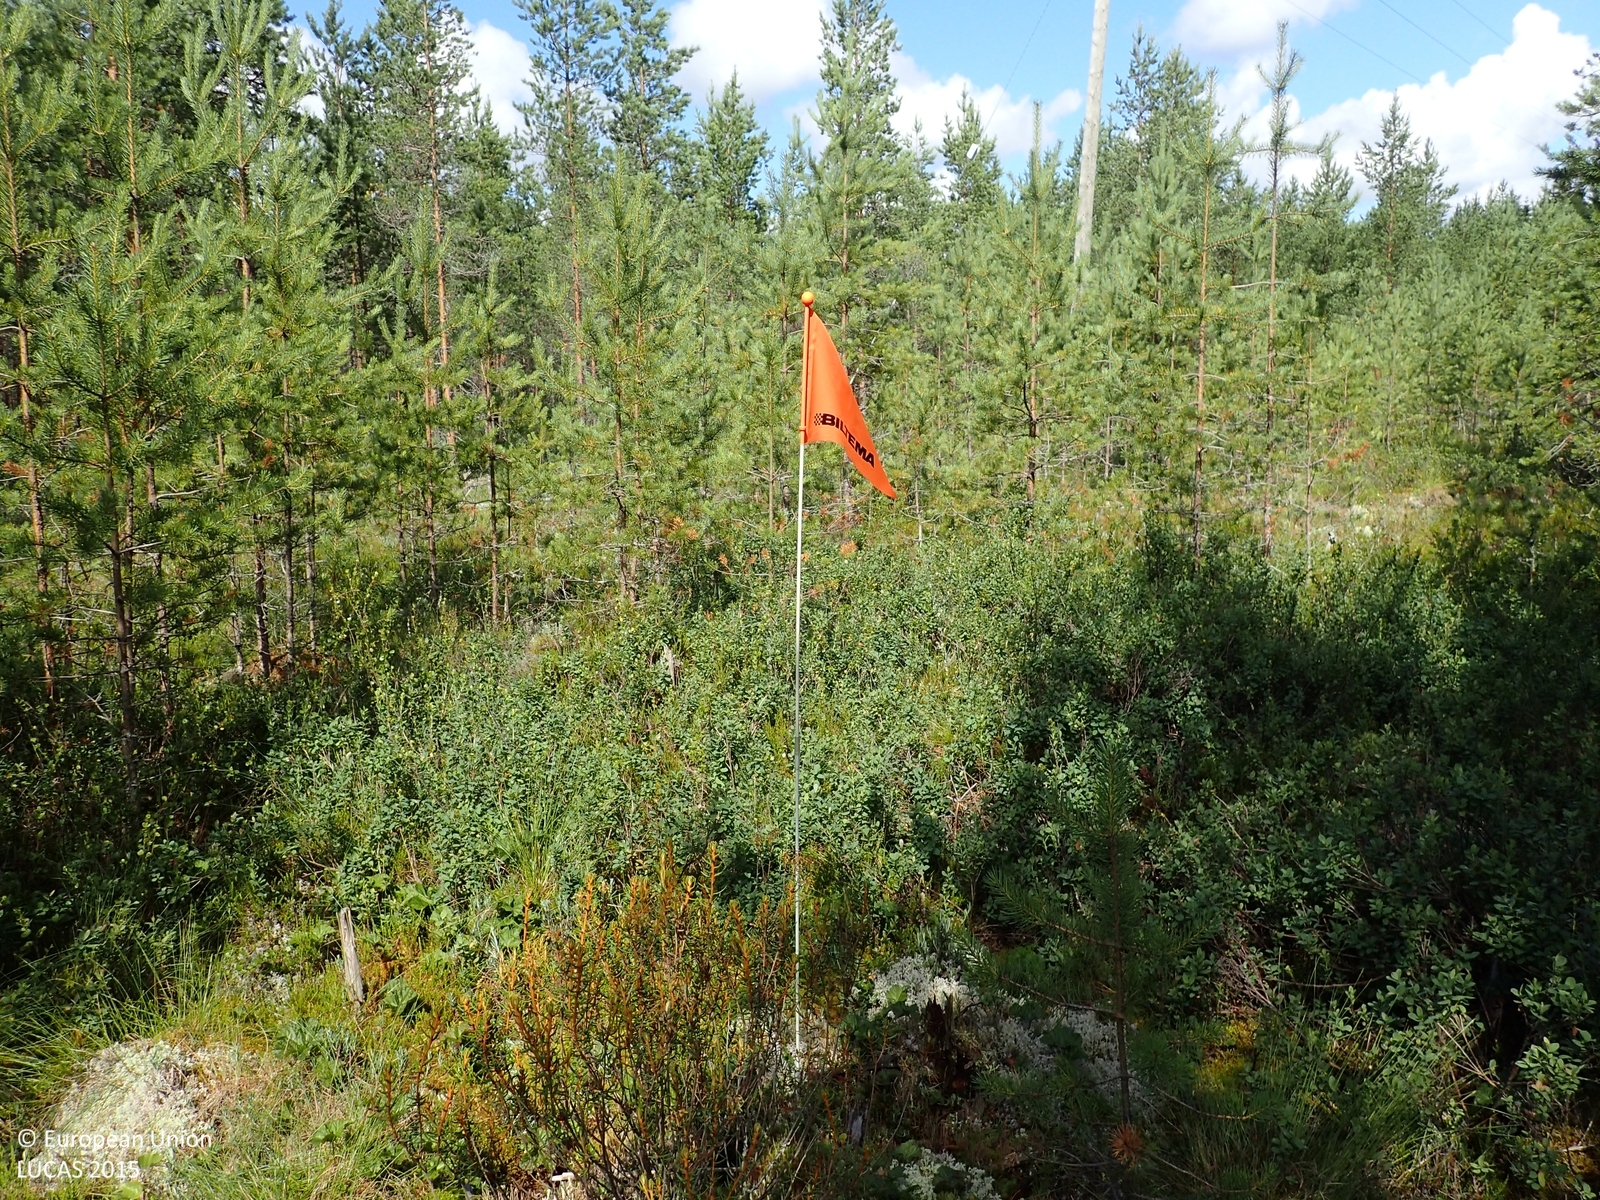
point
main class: Woodland
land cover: Pine dominated coniferous woodland
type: mire and swamp forests
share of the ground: 50 - 75 %
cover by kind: coniferous forest trees 60 %, shrubs 30 %, herbaceous plants 5 %, lichens and mosses 5 %
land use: Forestry
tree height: < 5 m
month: July
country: FI
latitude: 62.8987
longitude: 22.6668
